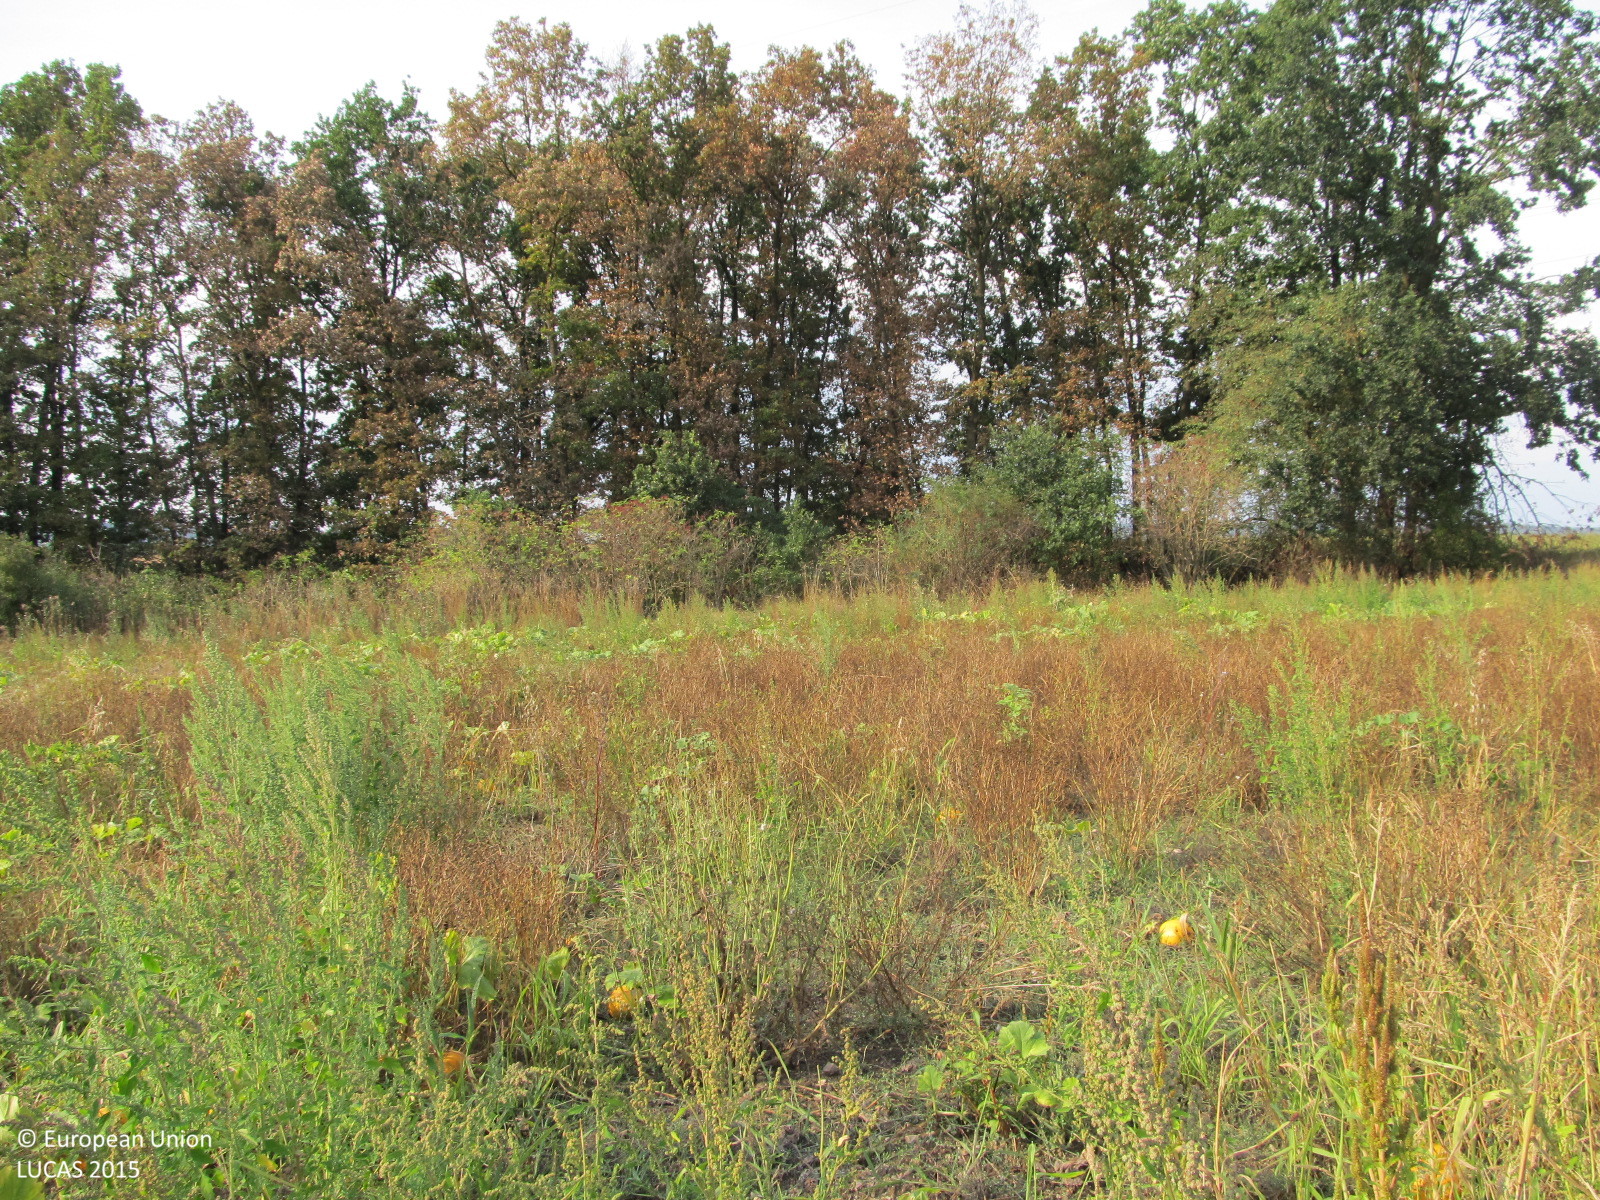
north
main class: Cropland
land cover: Other fibre and oleaginous crops
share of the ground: 50 - 75 %
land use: Agriculture (excluding fallow land and kitchen gardens)
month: August
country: AT
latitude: 48.6799
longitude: 15.5309
